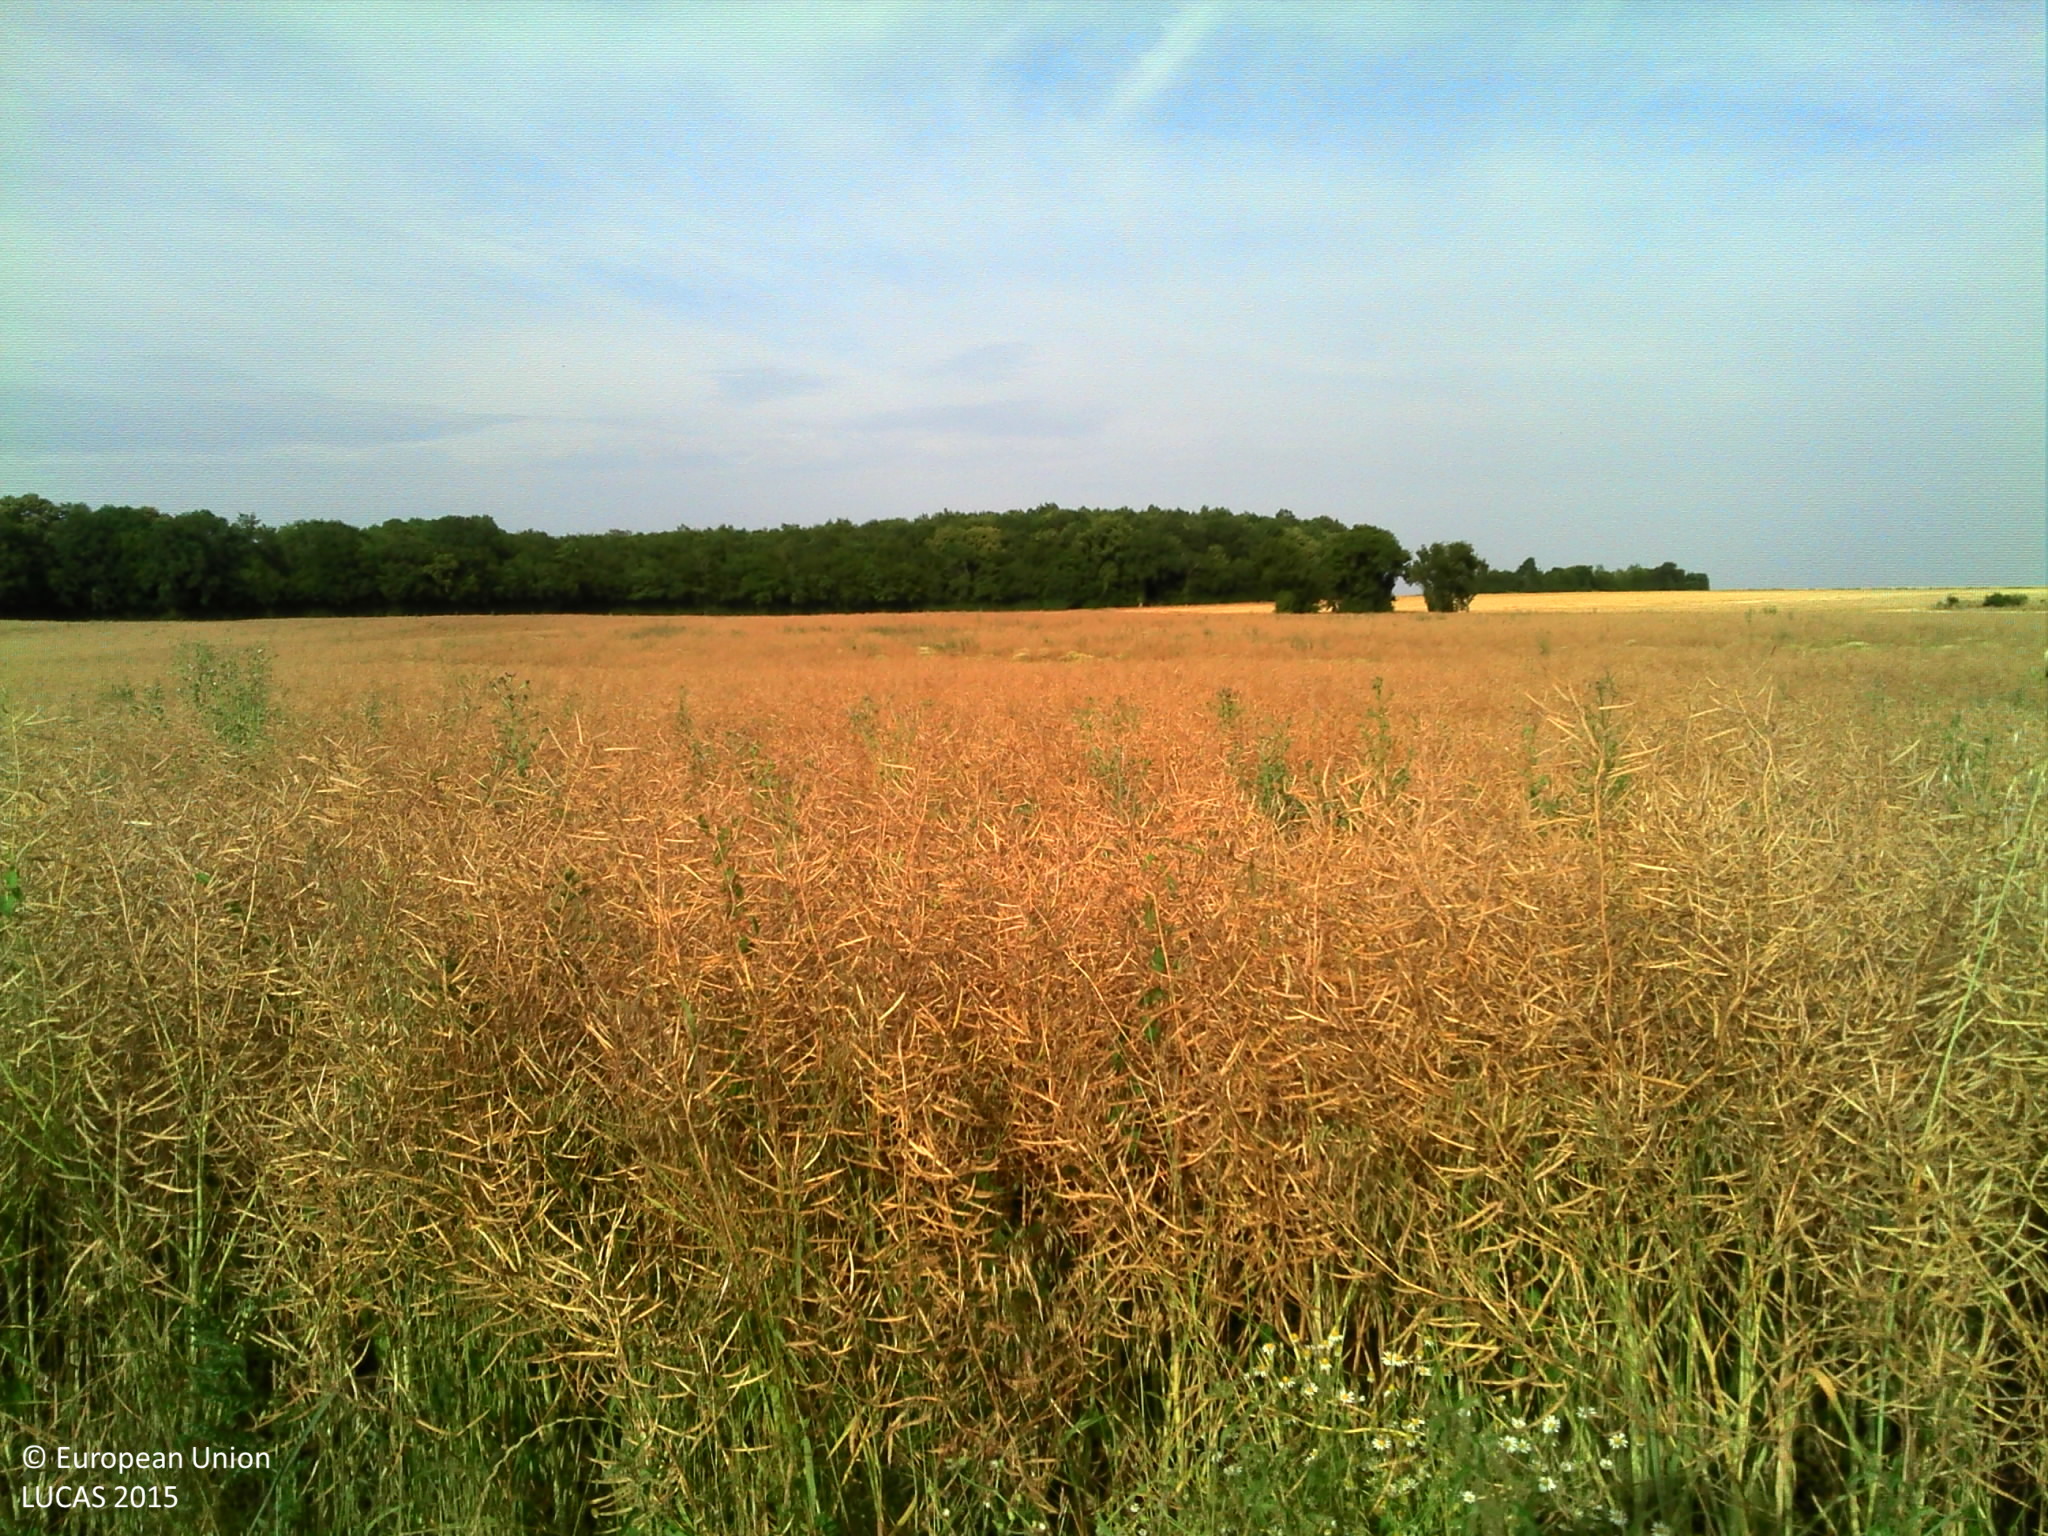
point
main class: Cropland
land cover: Rape and turnip rape
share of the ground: > 75 %
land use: Agriculture (excluding fallow land and kitchen gardens)
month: July
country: FR
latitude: 47.1514
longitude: 3.5746
